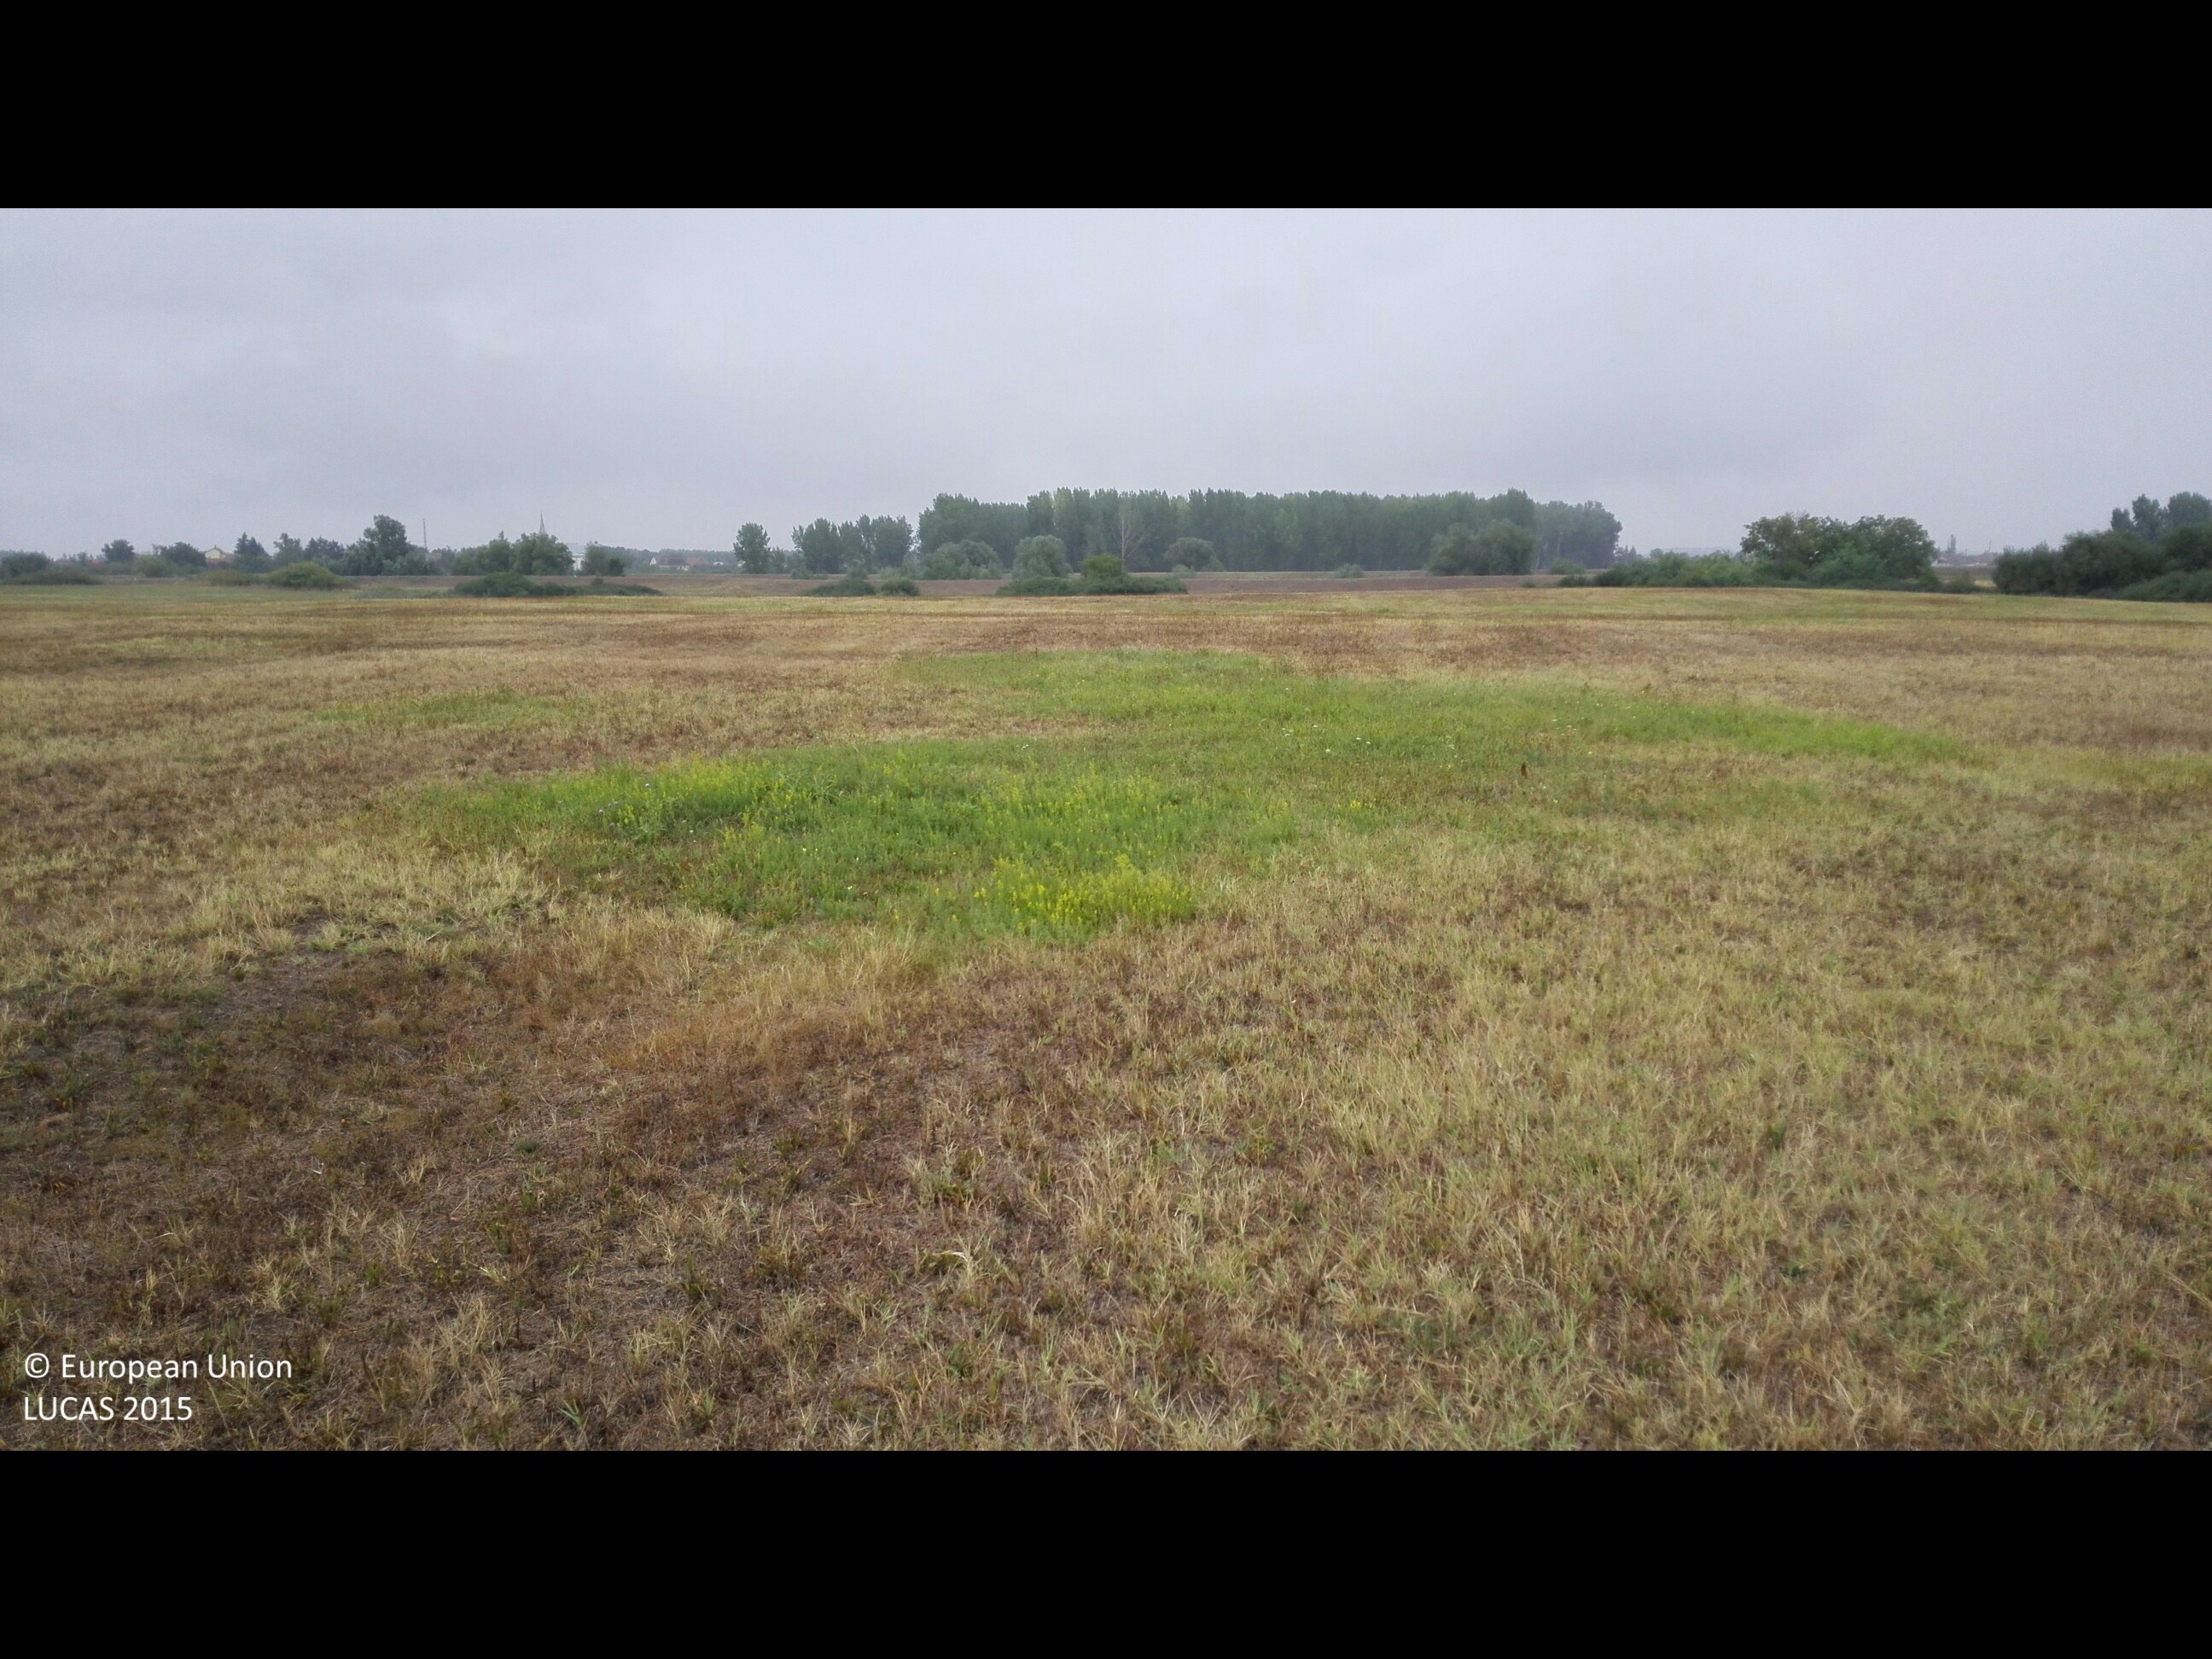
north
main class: Grassland
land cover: Grassland without tree/shrub cover
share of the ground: > 75 %
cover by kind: herbaceous plants 100 %
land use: Agriculture (excluding fallow land and kitchen gardens)
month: August
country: HU
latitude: 47.2755
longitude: 21.8242
